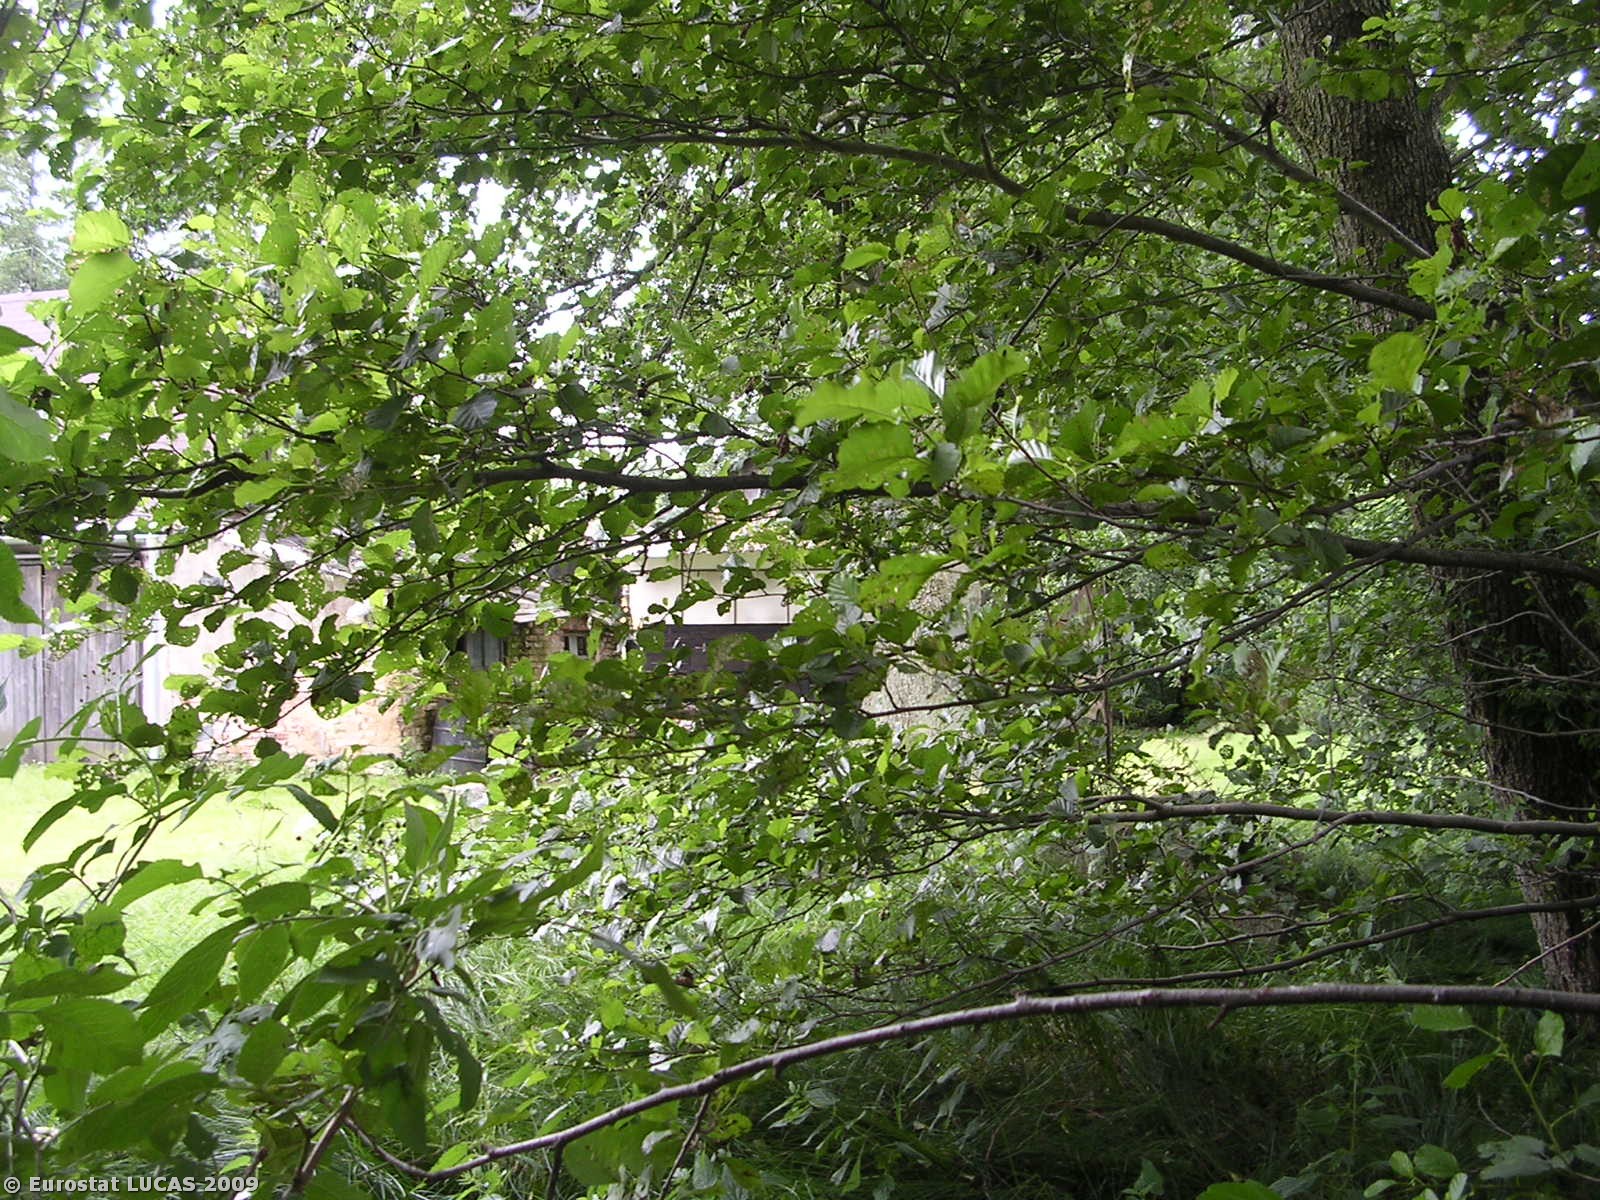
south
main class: Woodland
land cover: Broadleaved woodland
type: floodplain forest
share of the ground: > 75 %
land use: Unused
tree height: > 5 m
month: July
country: CZ
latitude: 50.9665
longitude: 15.2008
